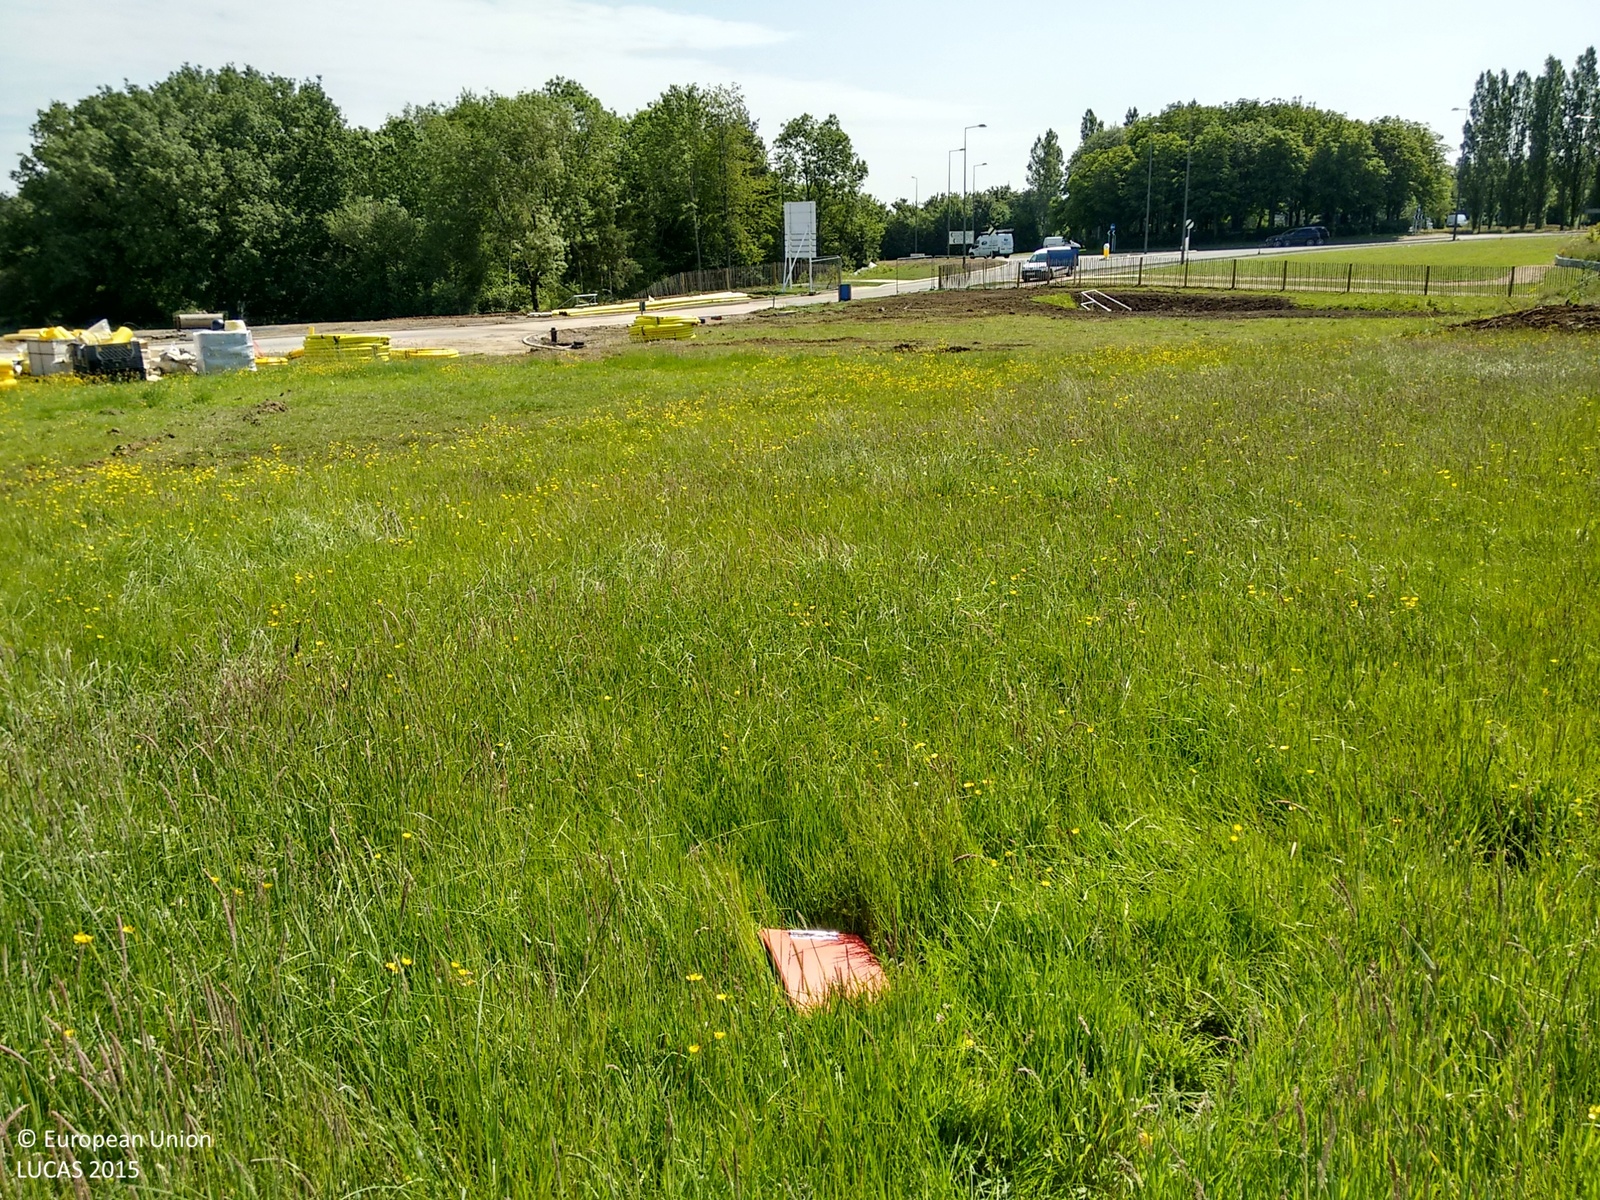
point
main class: Grassland
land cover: Grassland without tree/shrub cover
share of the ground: > 75 %
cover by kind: herbaceous plants 100 %
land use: Agriculture (excluding fallow land and kitchen gardens)
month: June
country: GB
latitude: 52.0272
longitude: -0.8127
